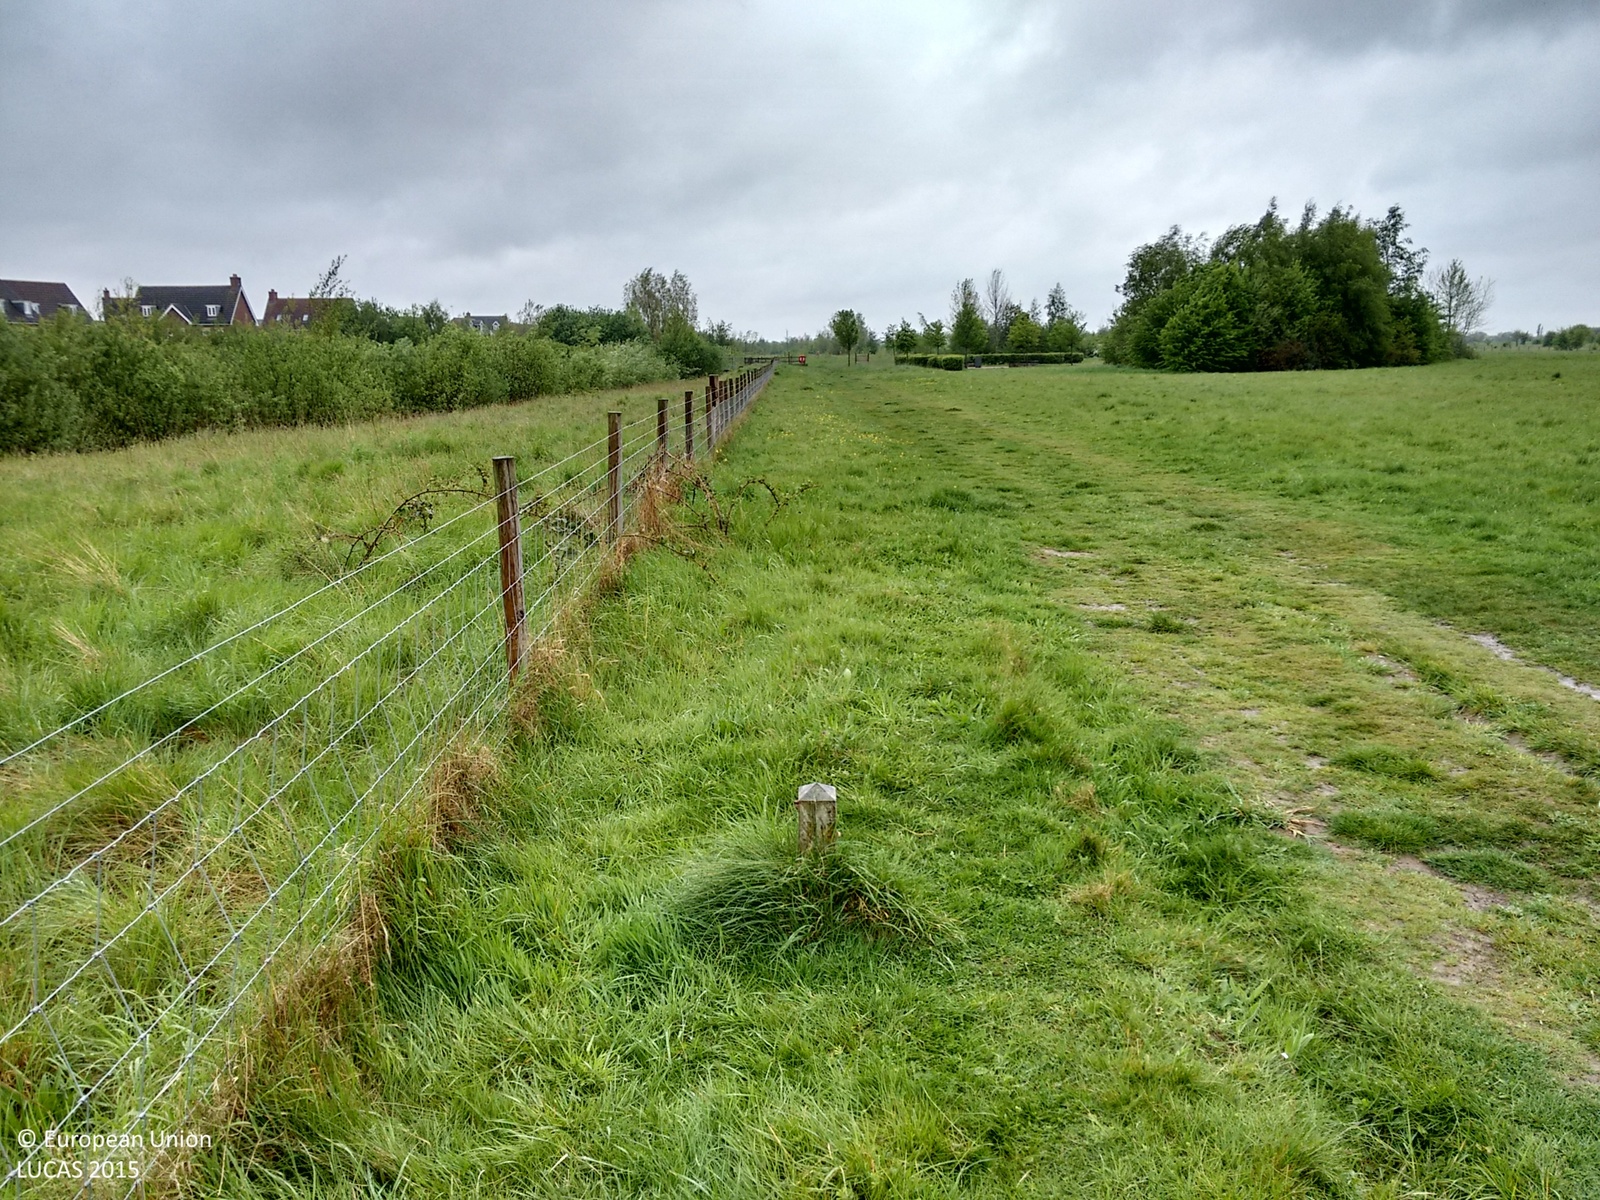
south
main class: Woodland
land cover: Broadleaved woodland
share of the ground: > 75 %
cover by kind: broadleaved forest trees 90 %, herbaceous plants 10 %
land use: Semi-natural and natural areas not in use
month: May
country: GB
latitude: 51.7693
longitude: -0.2519
